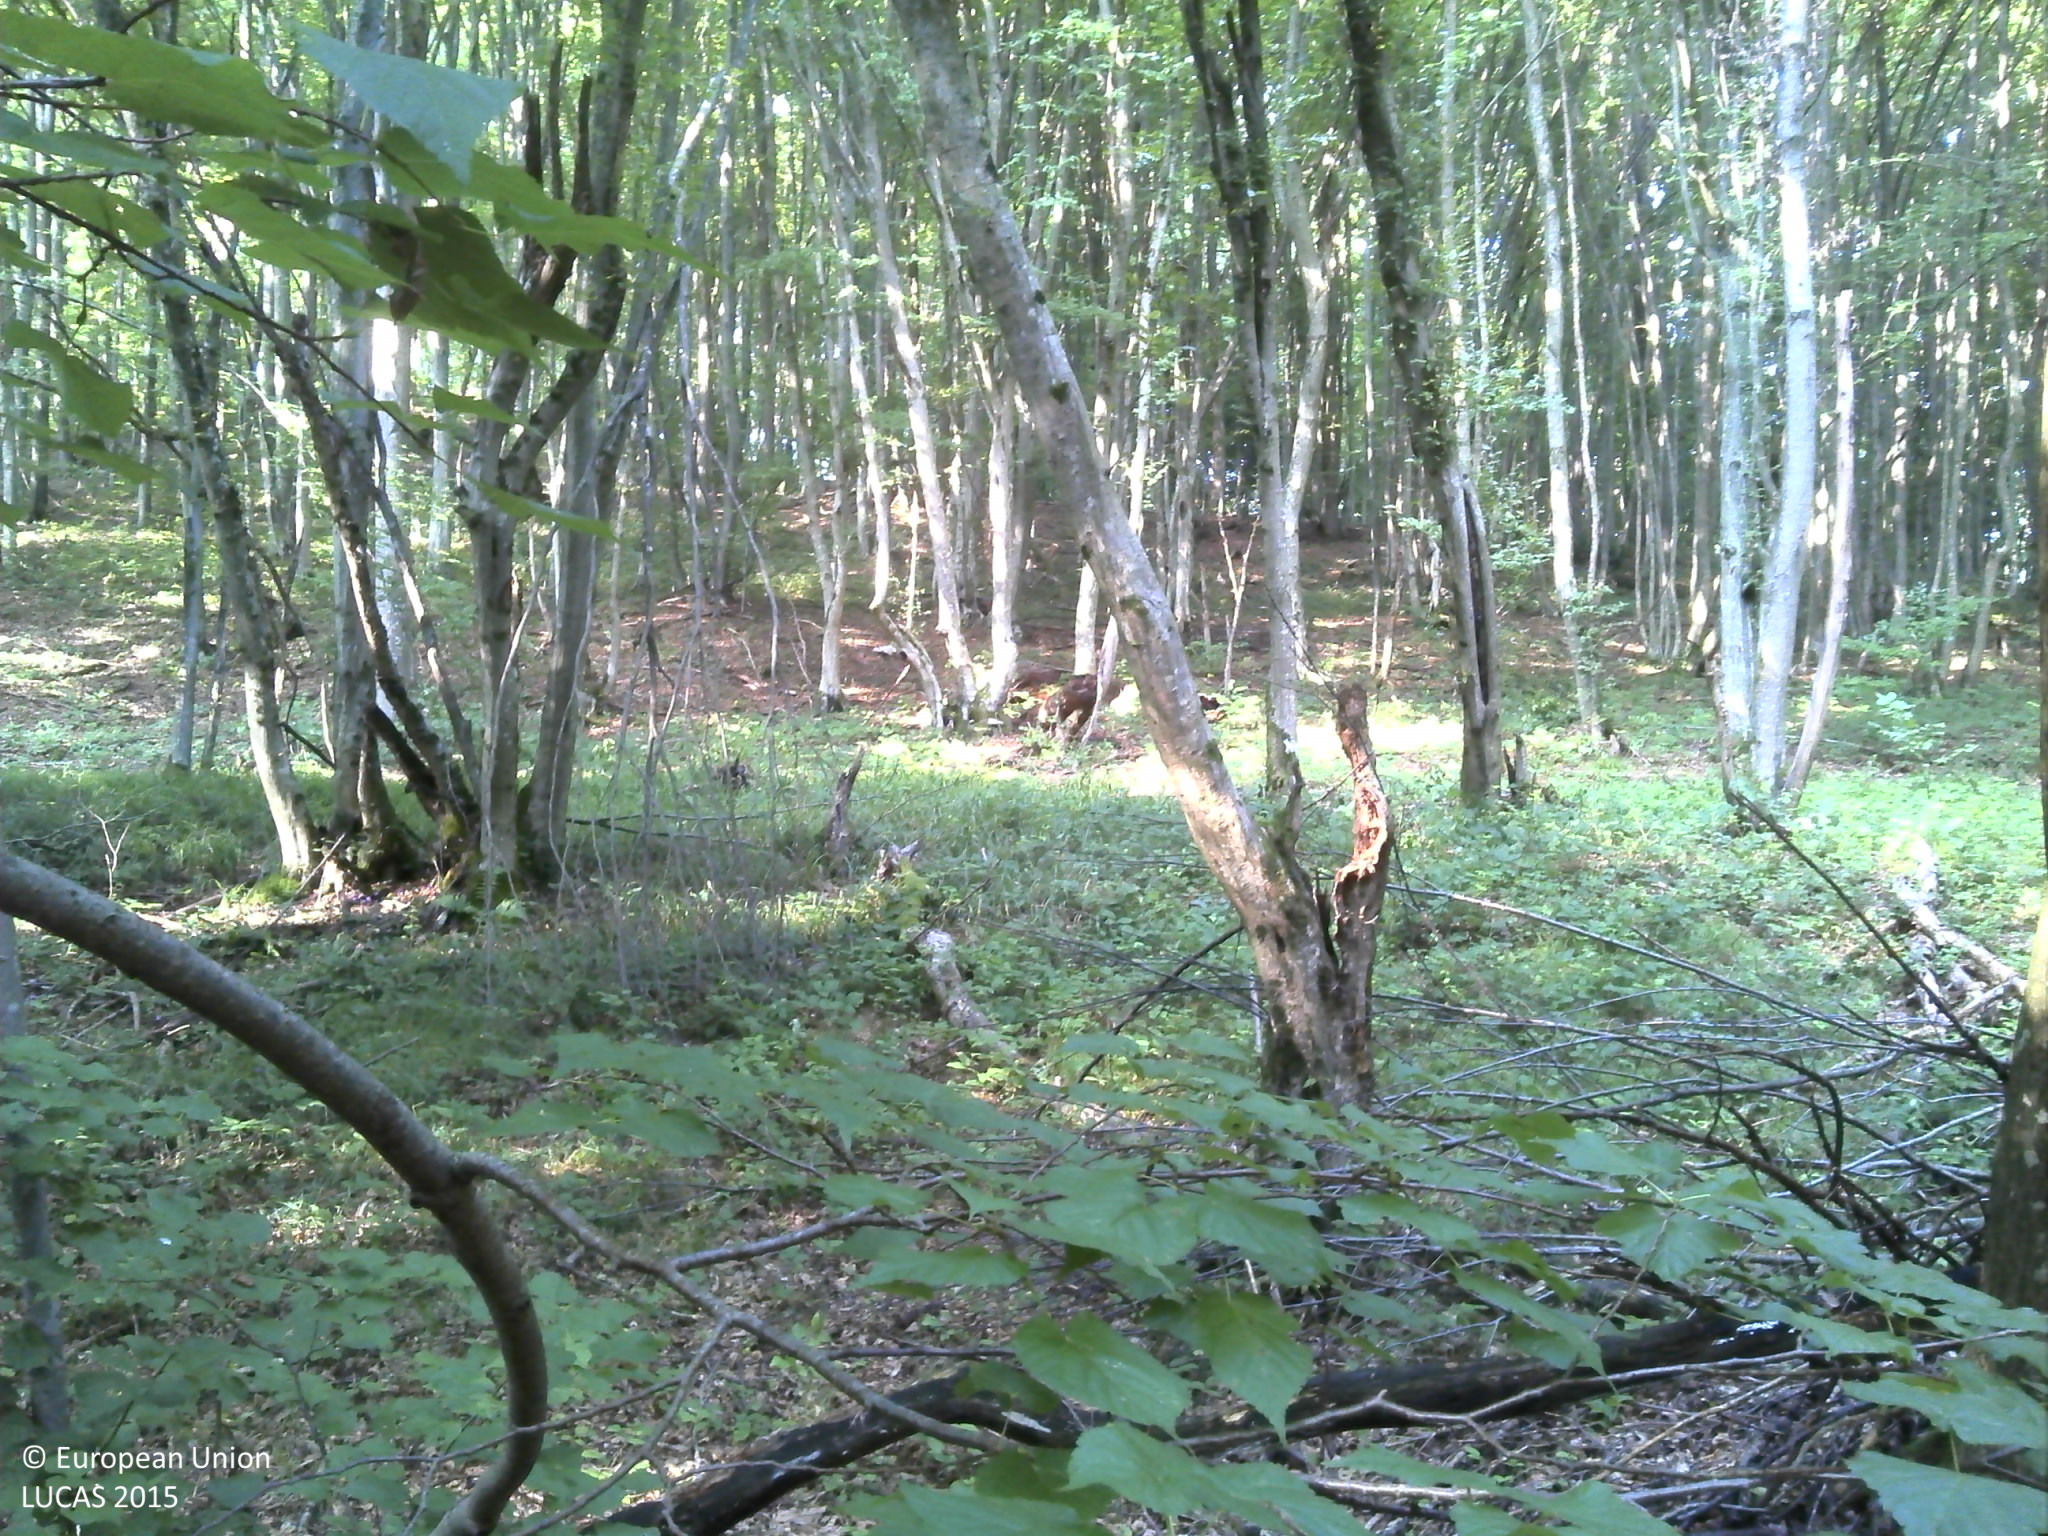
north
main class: Woodland
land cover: Broadleaved woodland
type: beech forest
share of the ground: > 75 %
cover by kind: broadleaved forest trees 100 %
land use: Forestry
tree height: > 5 m
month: August
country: HR
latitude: 45.2641
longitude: 16.5610
